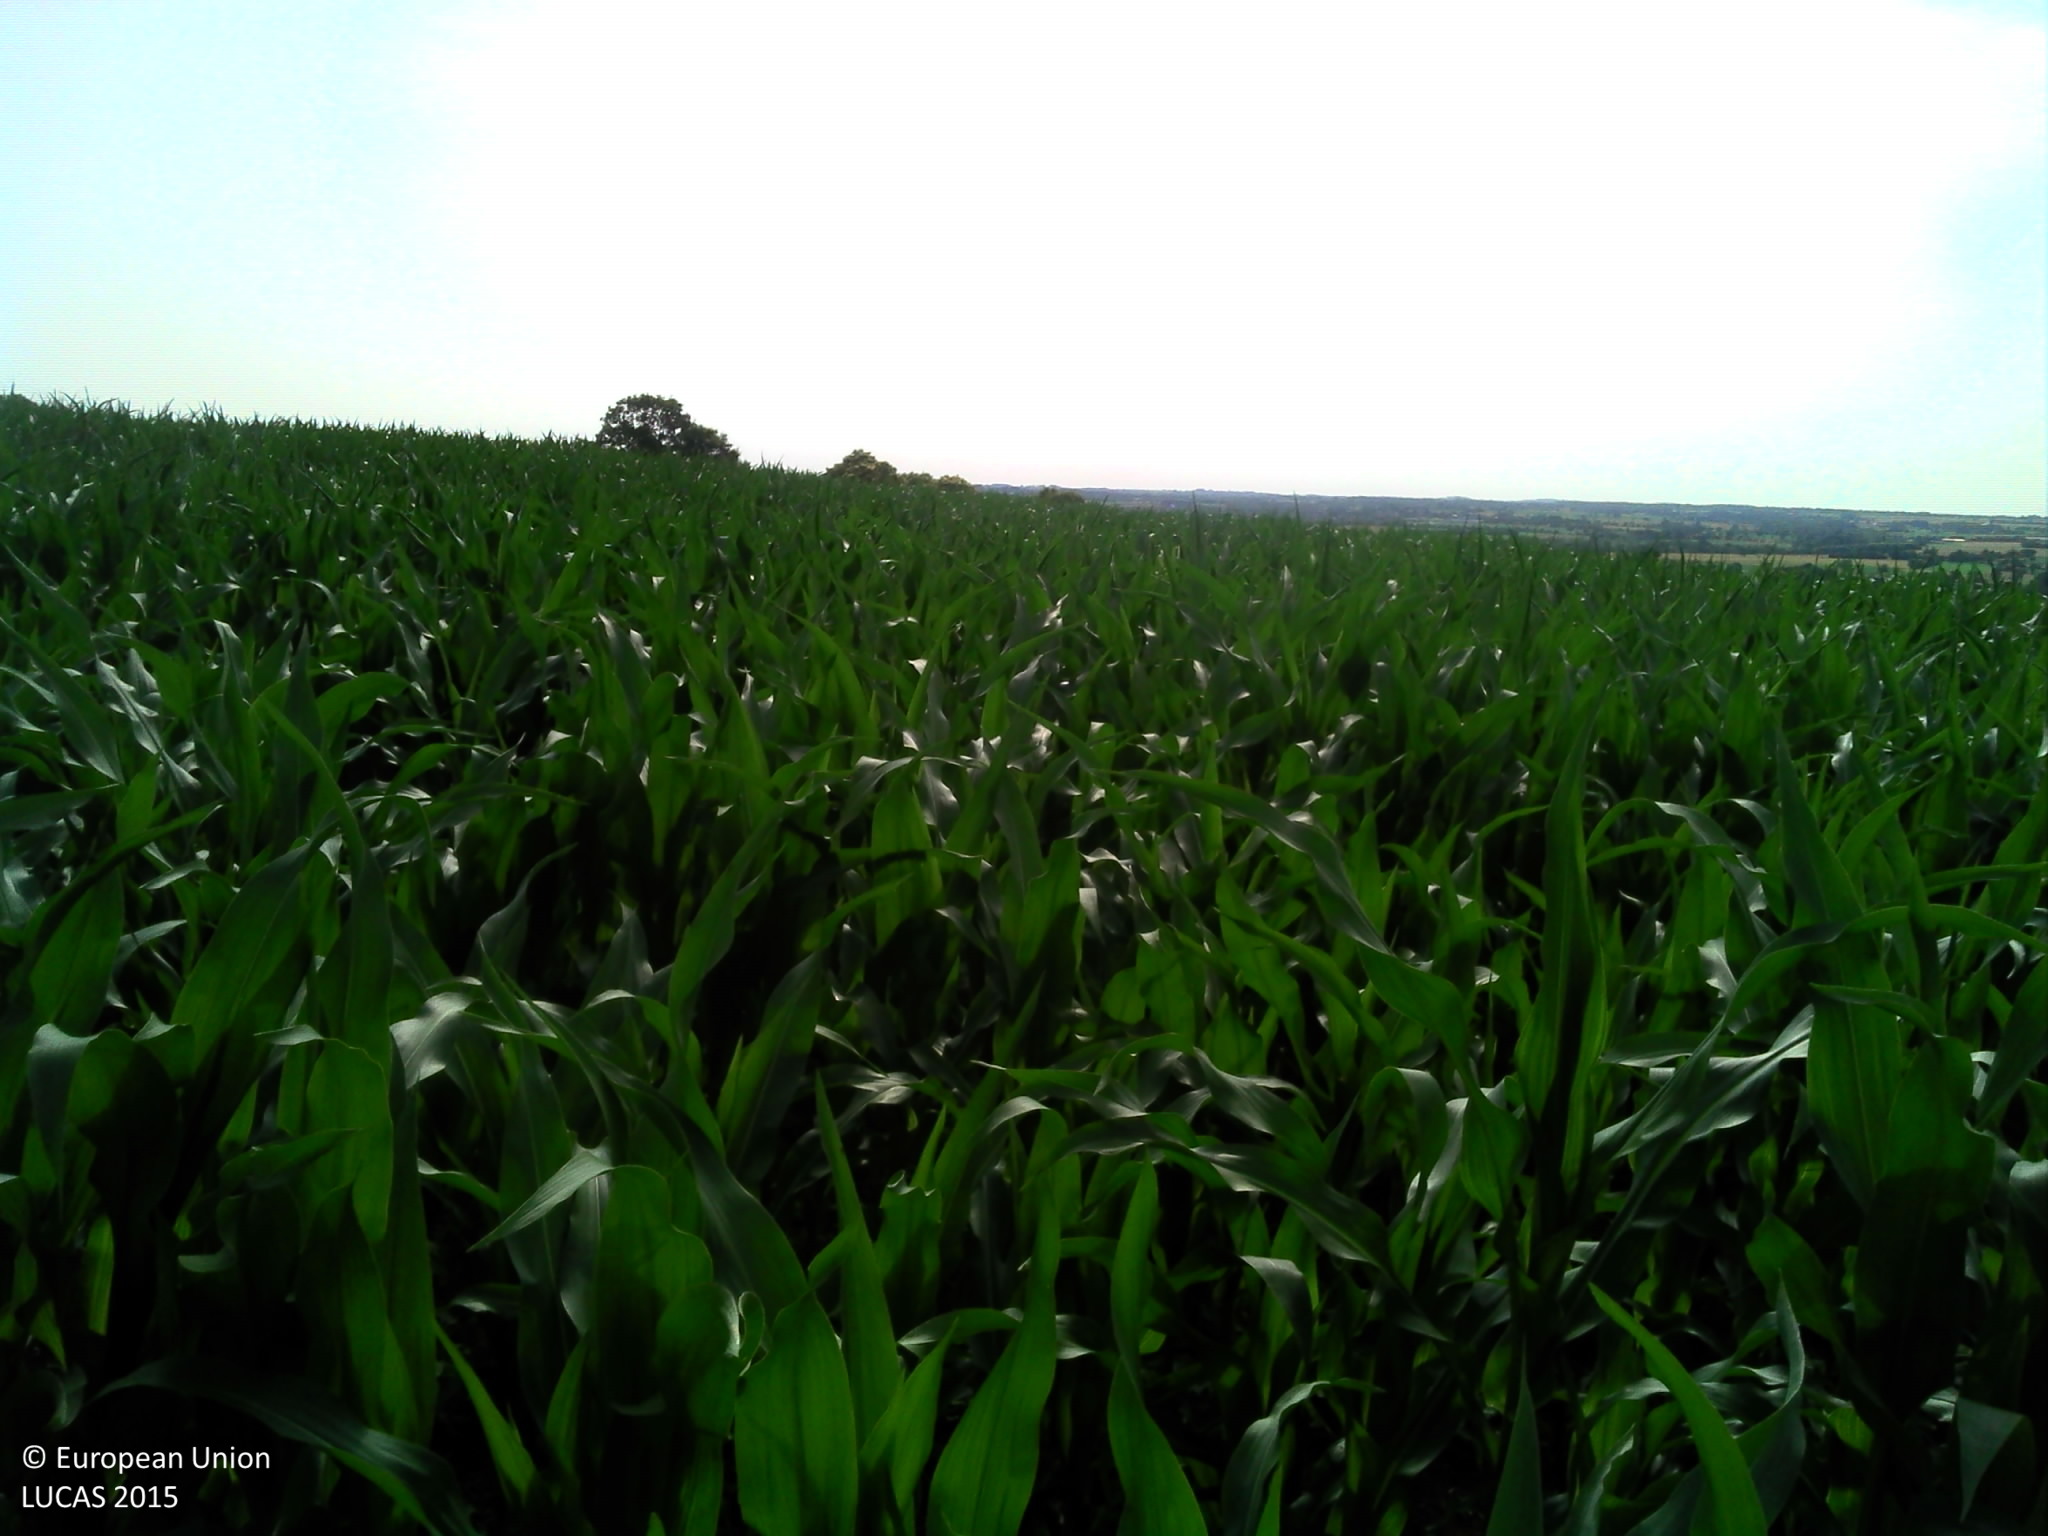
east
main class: Cropland
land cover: Maize
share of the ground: > 75 %
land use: Agriculture (excluding fallow land and kitchen gardens)
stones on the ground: 10 - 25 %
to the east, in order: Maize; Electric lines; Maize; Grass margins; Tracks; Barley
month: July
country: FR
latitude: 48.4732
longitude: -1.5040
